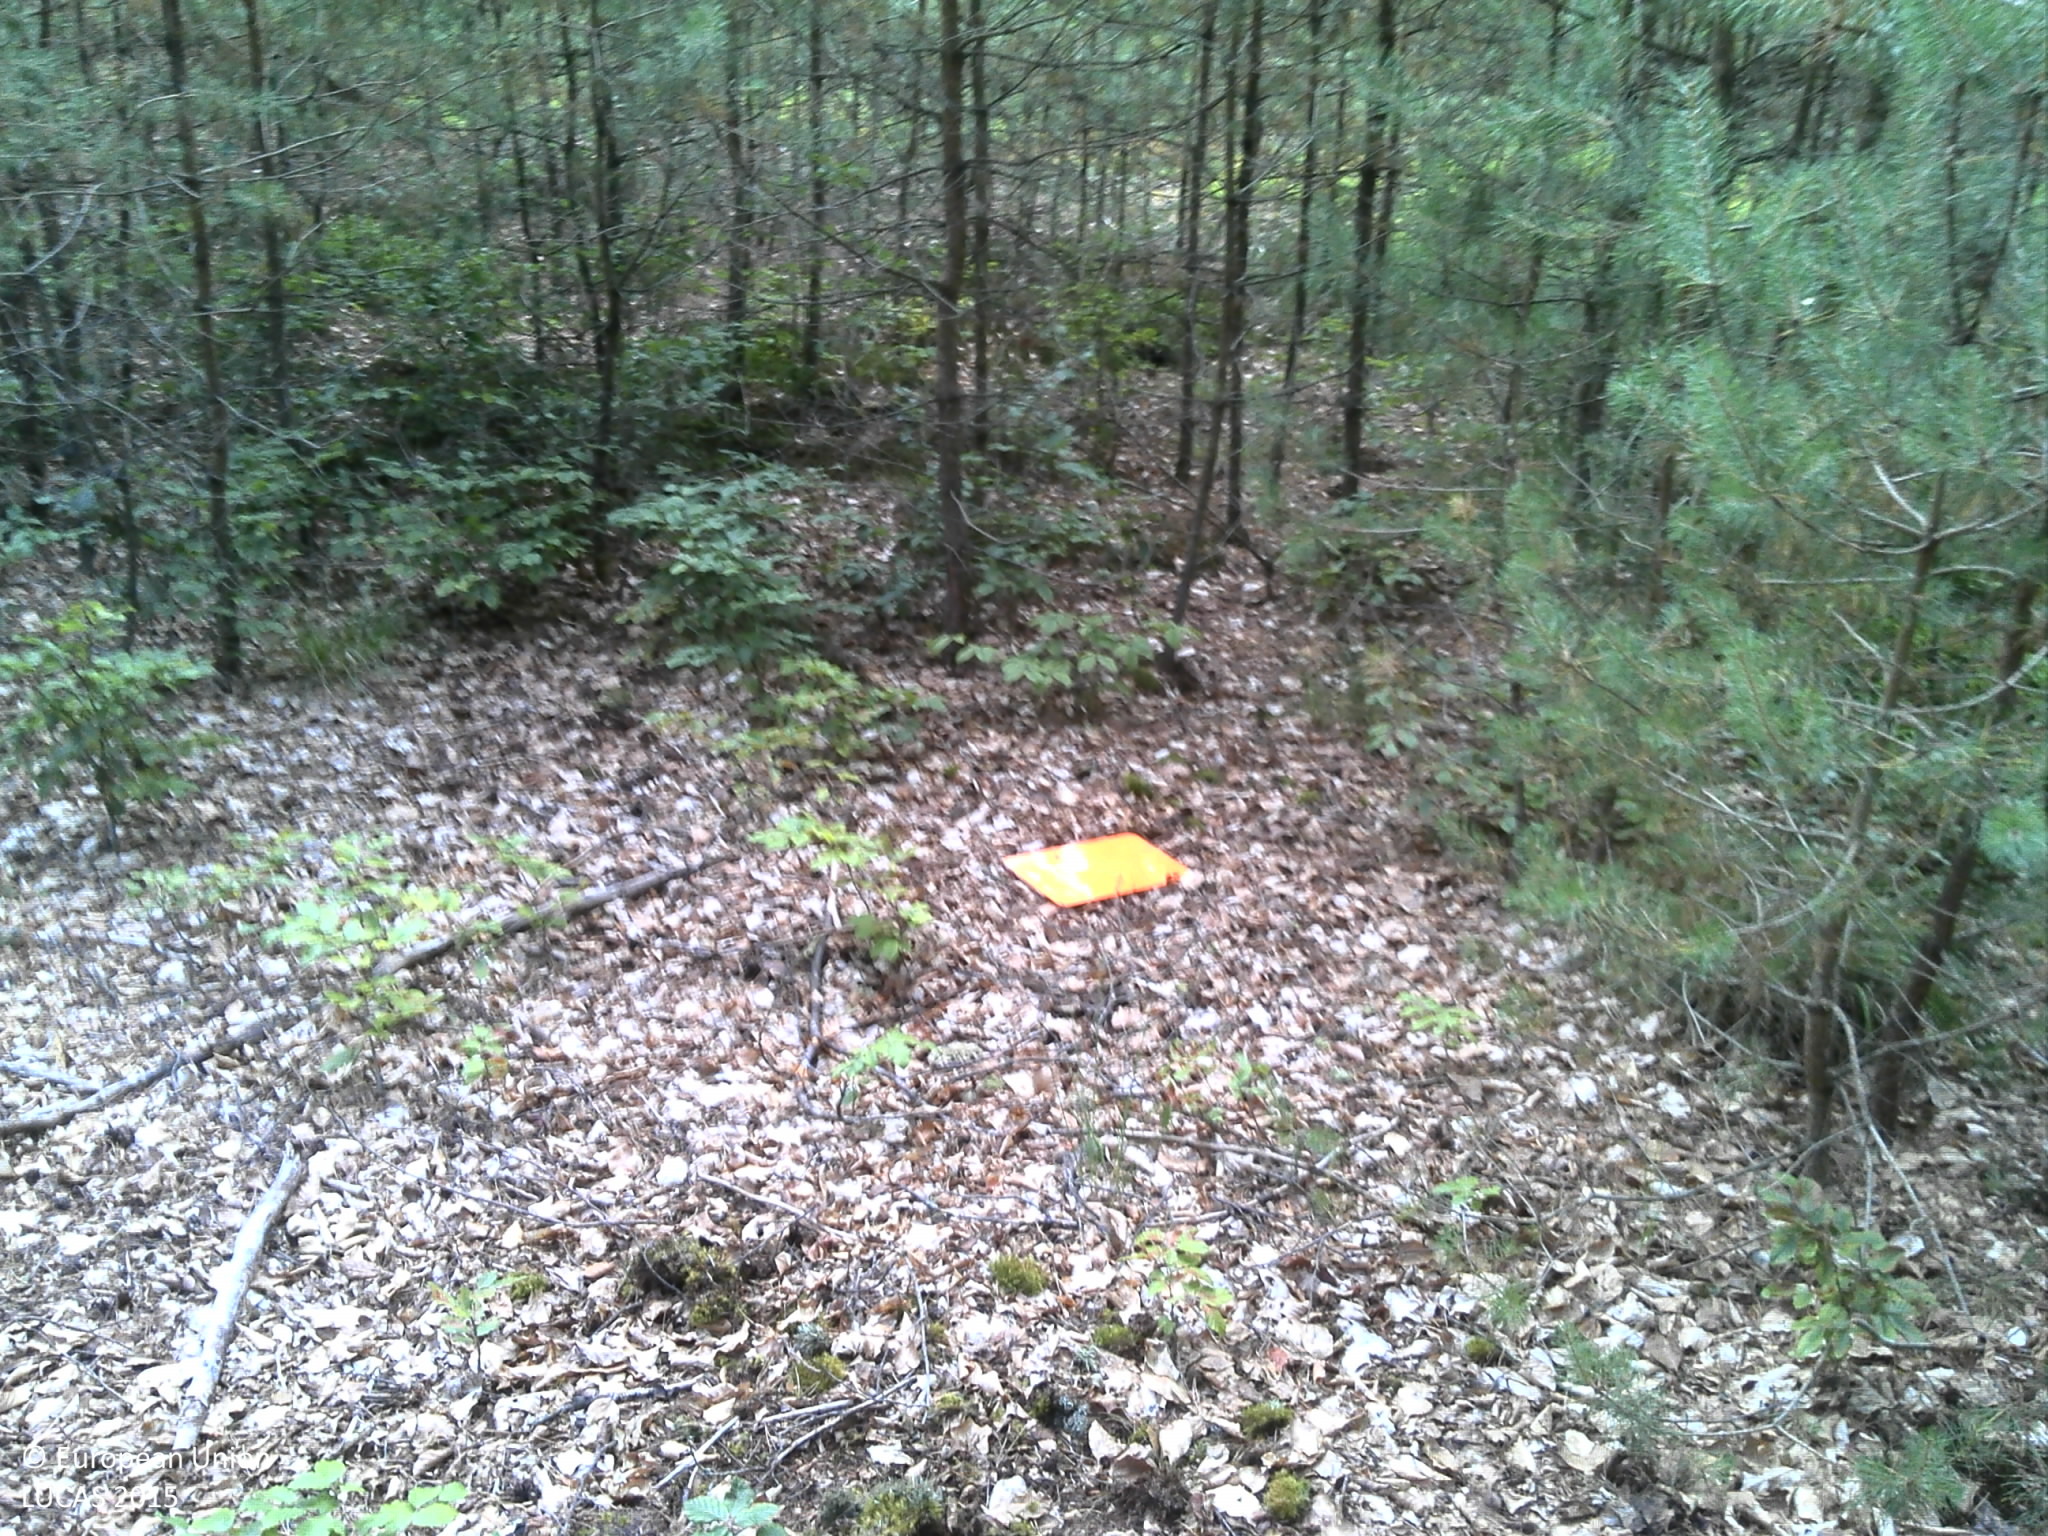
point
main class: Woodland
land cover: Pine dominated mixed woodland
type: hemiboreal forest and nemoral coniferous forest and mixed broadleaved-coniferous forest
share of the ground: > 75 %
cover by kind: coniferous forest trees 40 %, broadleaved forest trees 40 %, unconsolidated bare surface 10 %, herbaceous plants 5 %, lichens and mosses 5 %
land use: Forestry
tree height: > 5 m
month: July
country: FR
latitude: 49.0441
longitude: 7.6338
